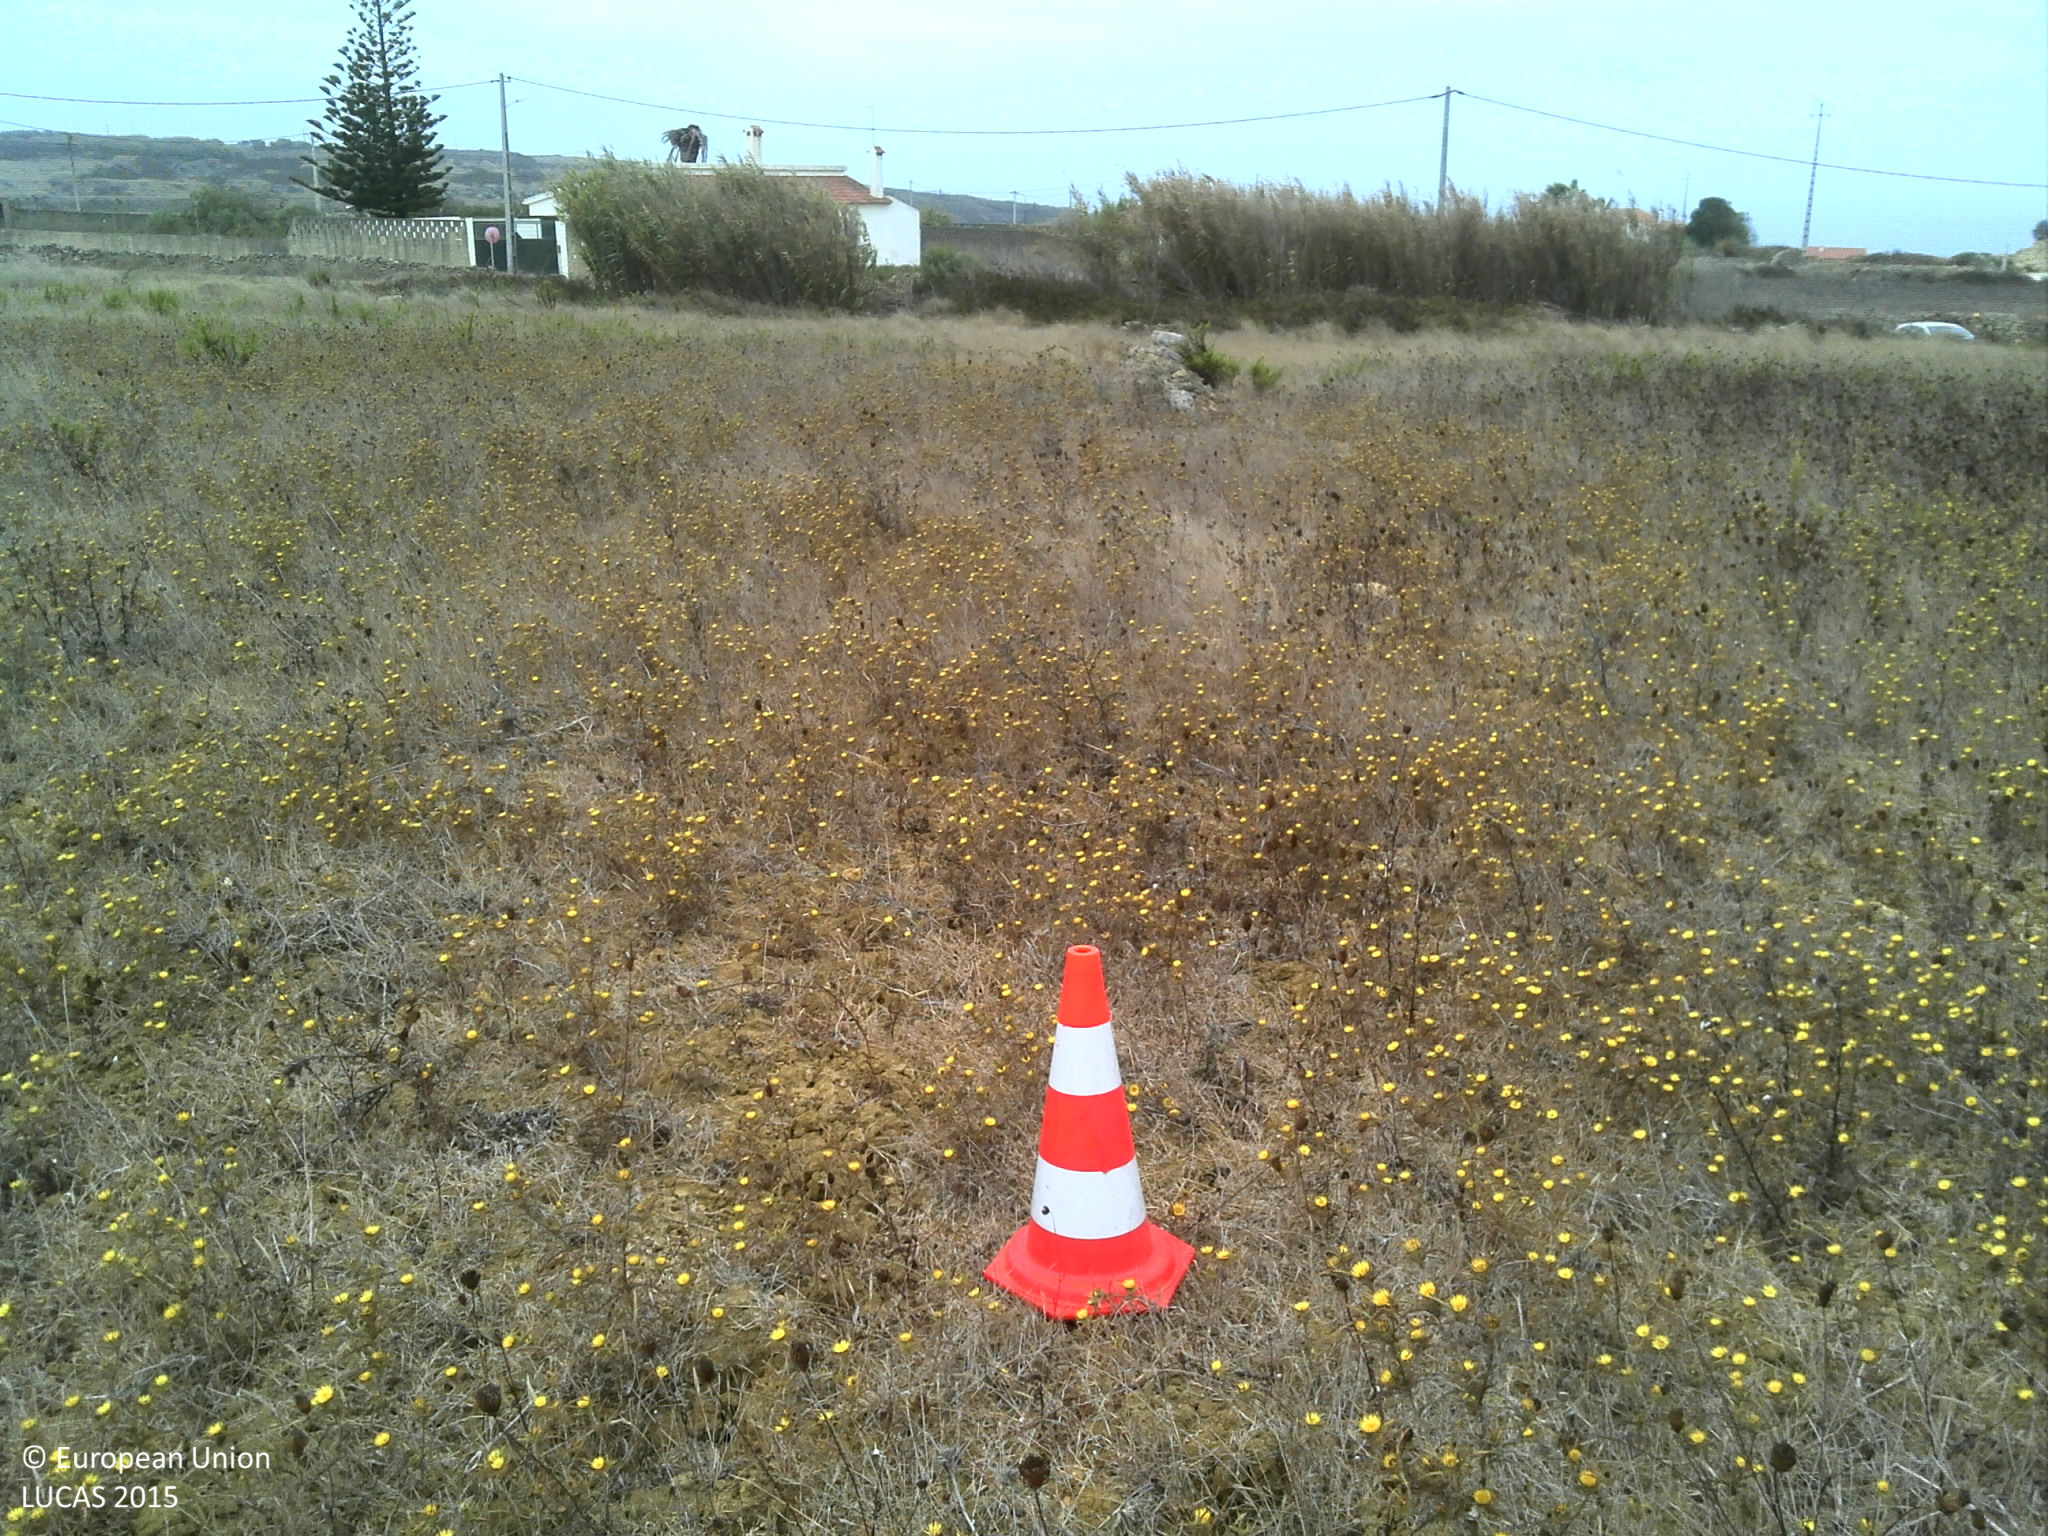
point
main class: Grassland
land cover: Grassland without tree/shrub cover
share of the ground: 25 - 50 %
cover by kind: unconsolidated bare surface 60 %, herbaceous plants 40 %
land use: Agriculture (excluding fallow land and kitchen gardens)
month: August
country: PT
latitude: 38.8984
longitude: -9.4234
